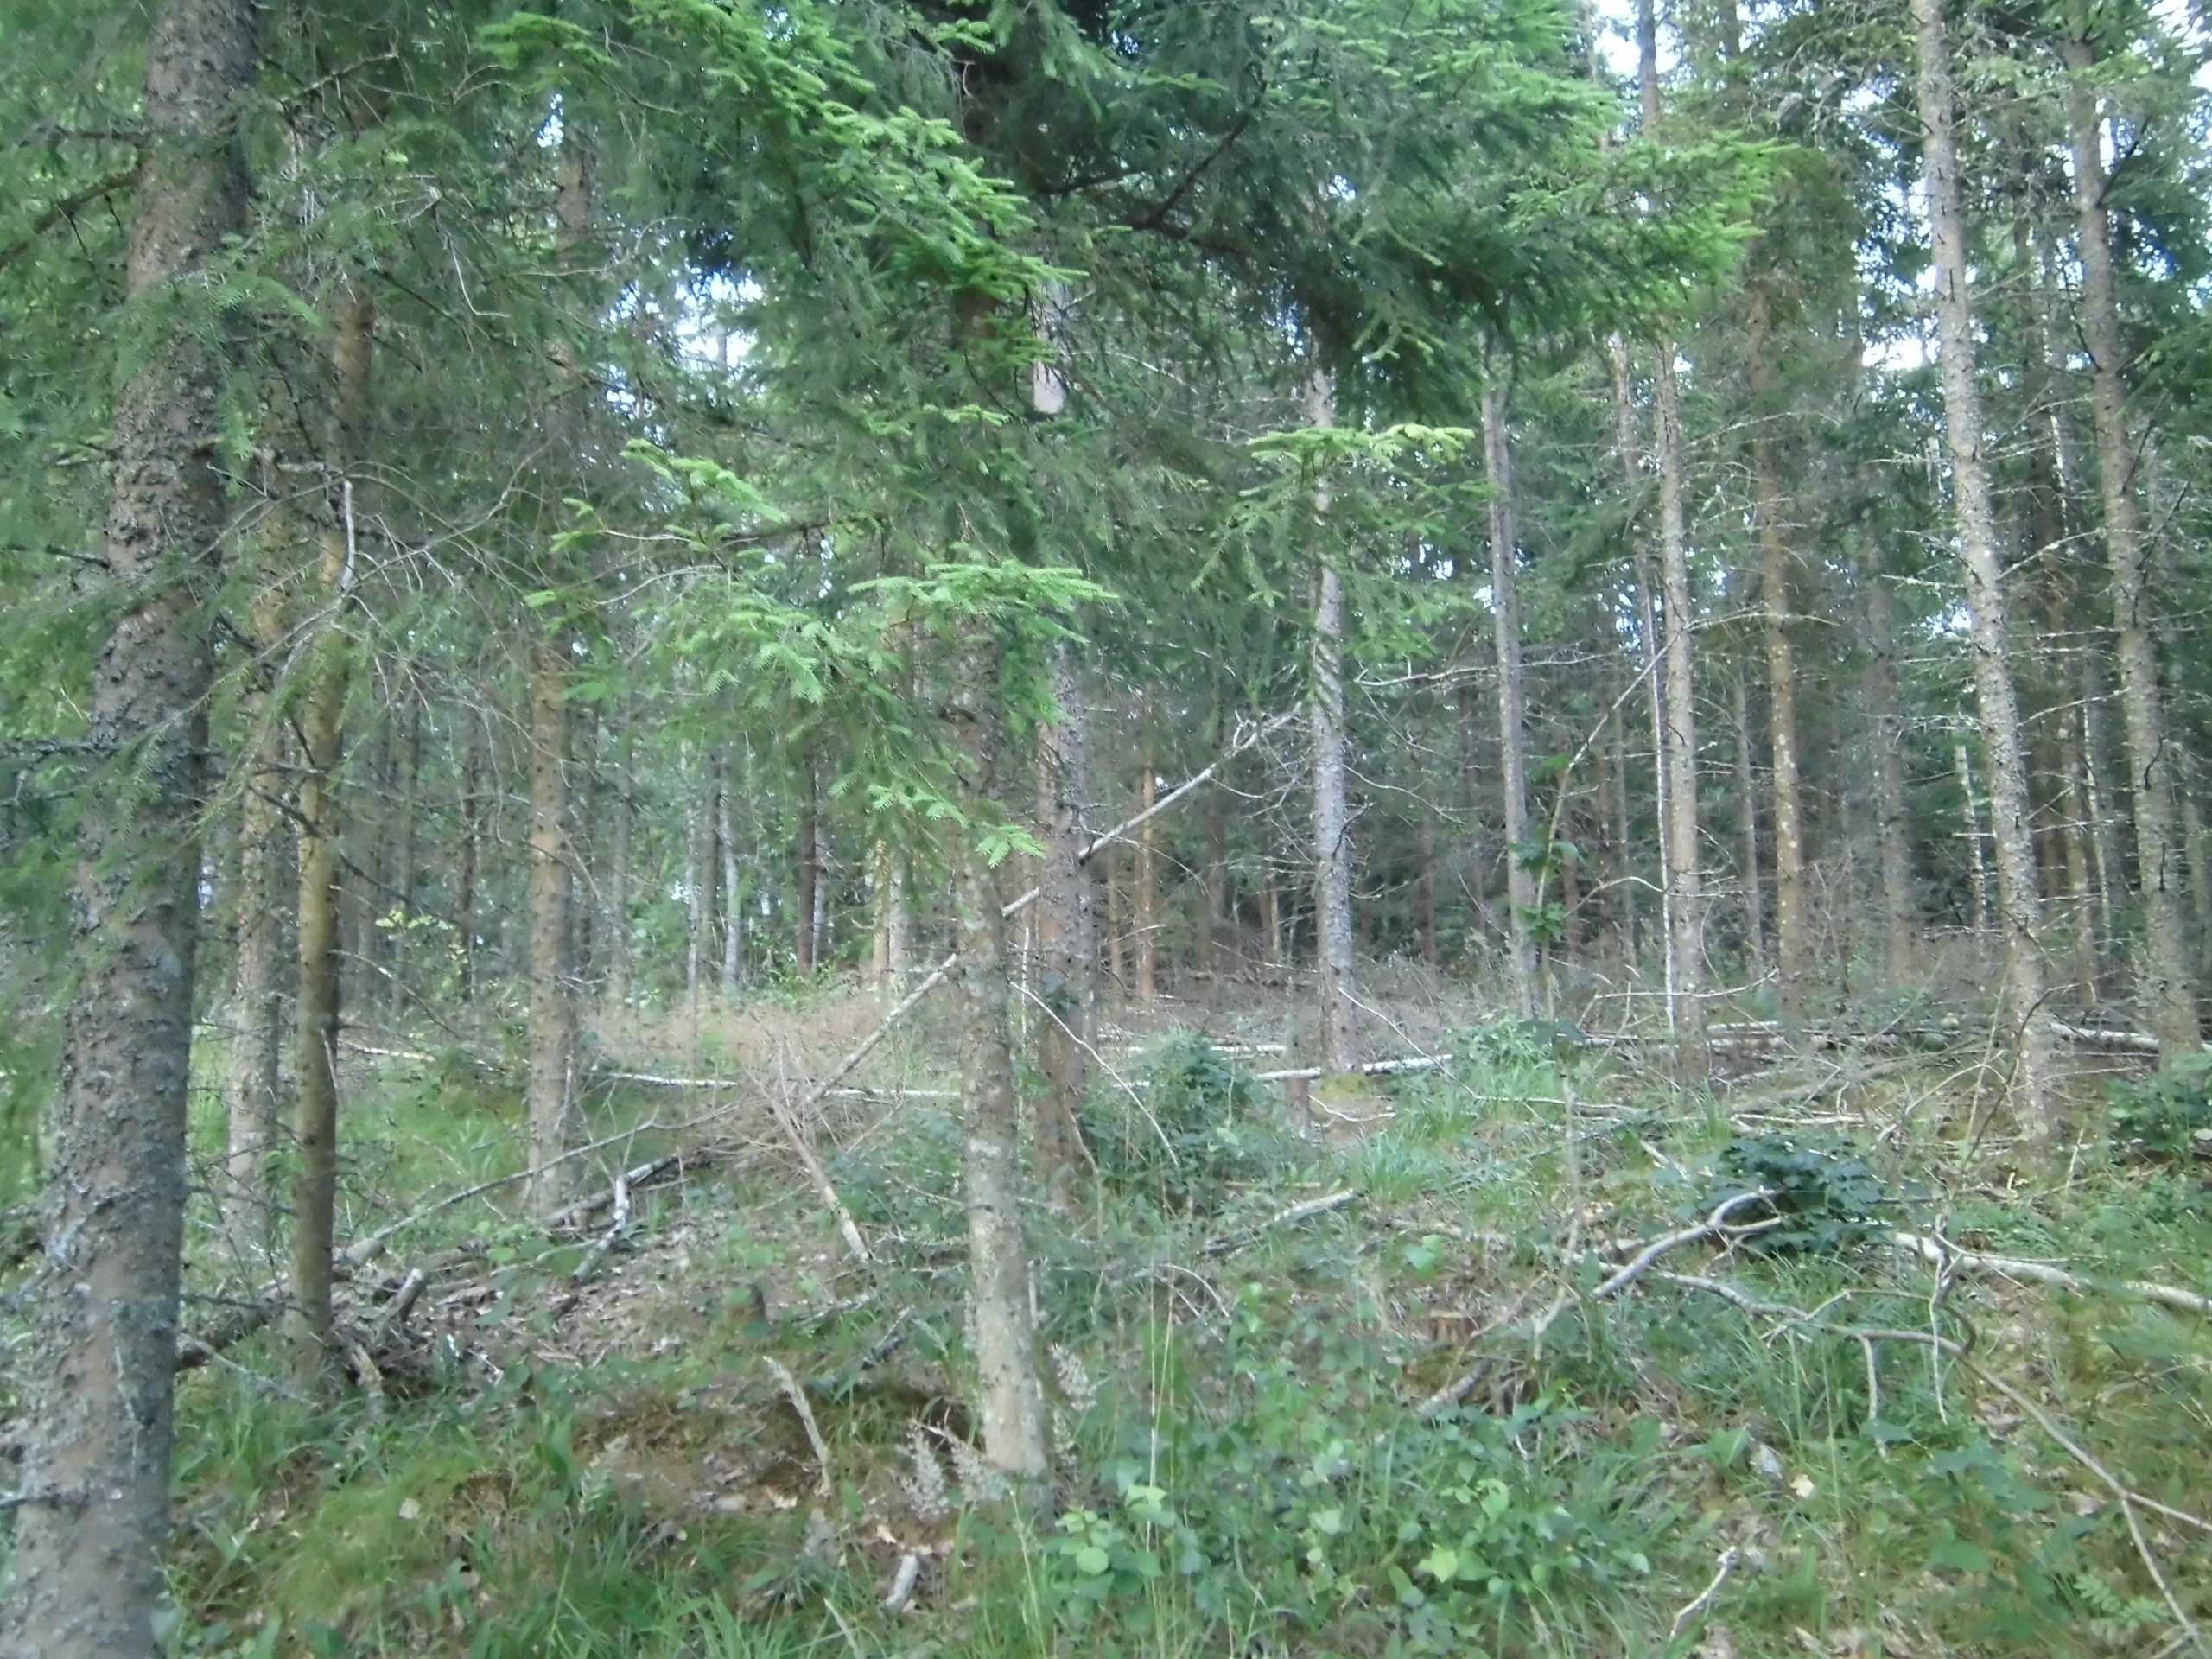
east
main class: Woodland
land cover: Spruce dominated mixed woodland
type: boreal forest
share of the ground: 50 - 75 %
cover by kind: coniferous forest trees 30 %, shrubs 25 %, broadleaved forest trees 20 %, herbaceous plants 15 %, lichens and mosses 10 %
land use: Forestry
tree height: > 5 m
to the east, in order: Spruce dominated mixed woodland; Spruce dominated coniferous woodland; Spruce dominated mixed woodland; Rivers and streams; Spruce dominated mixed woodland
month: July
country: SE
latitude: 57.3772
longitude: 15.2689
